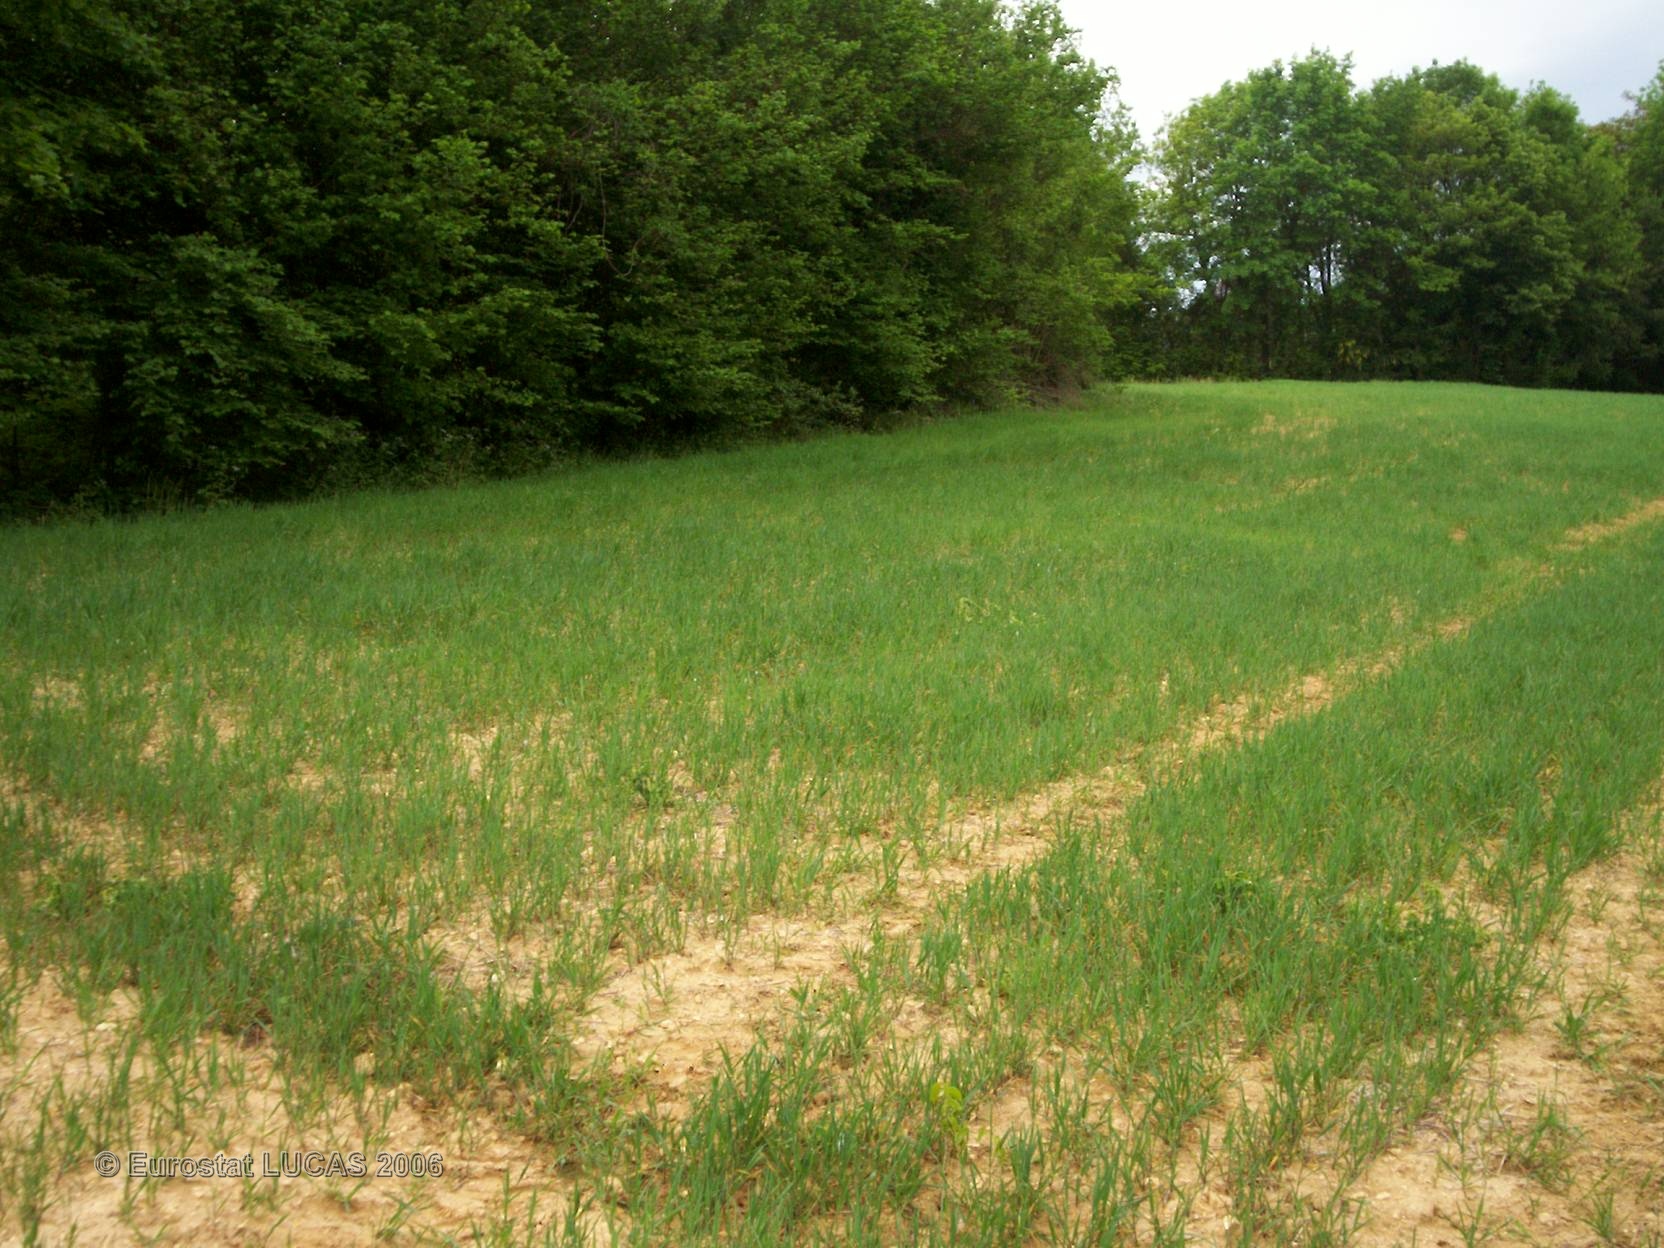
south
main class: Cropland
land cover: Barley
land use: Agriculture (excluding fallow land and kitchen gardens)
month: May
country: FR
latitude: 46.9124
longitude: 0.9908
